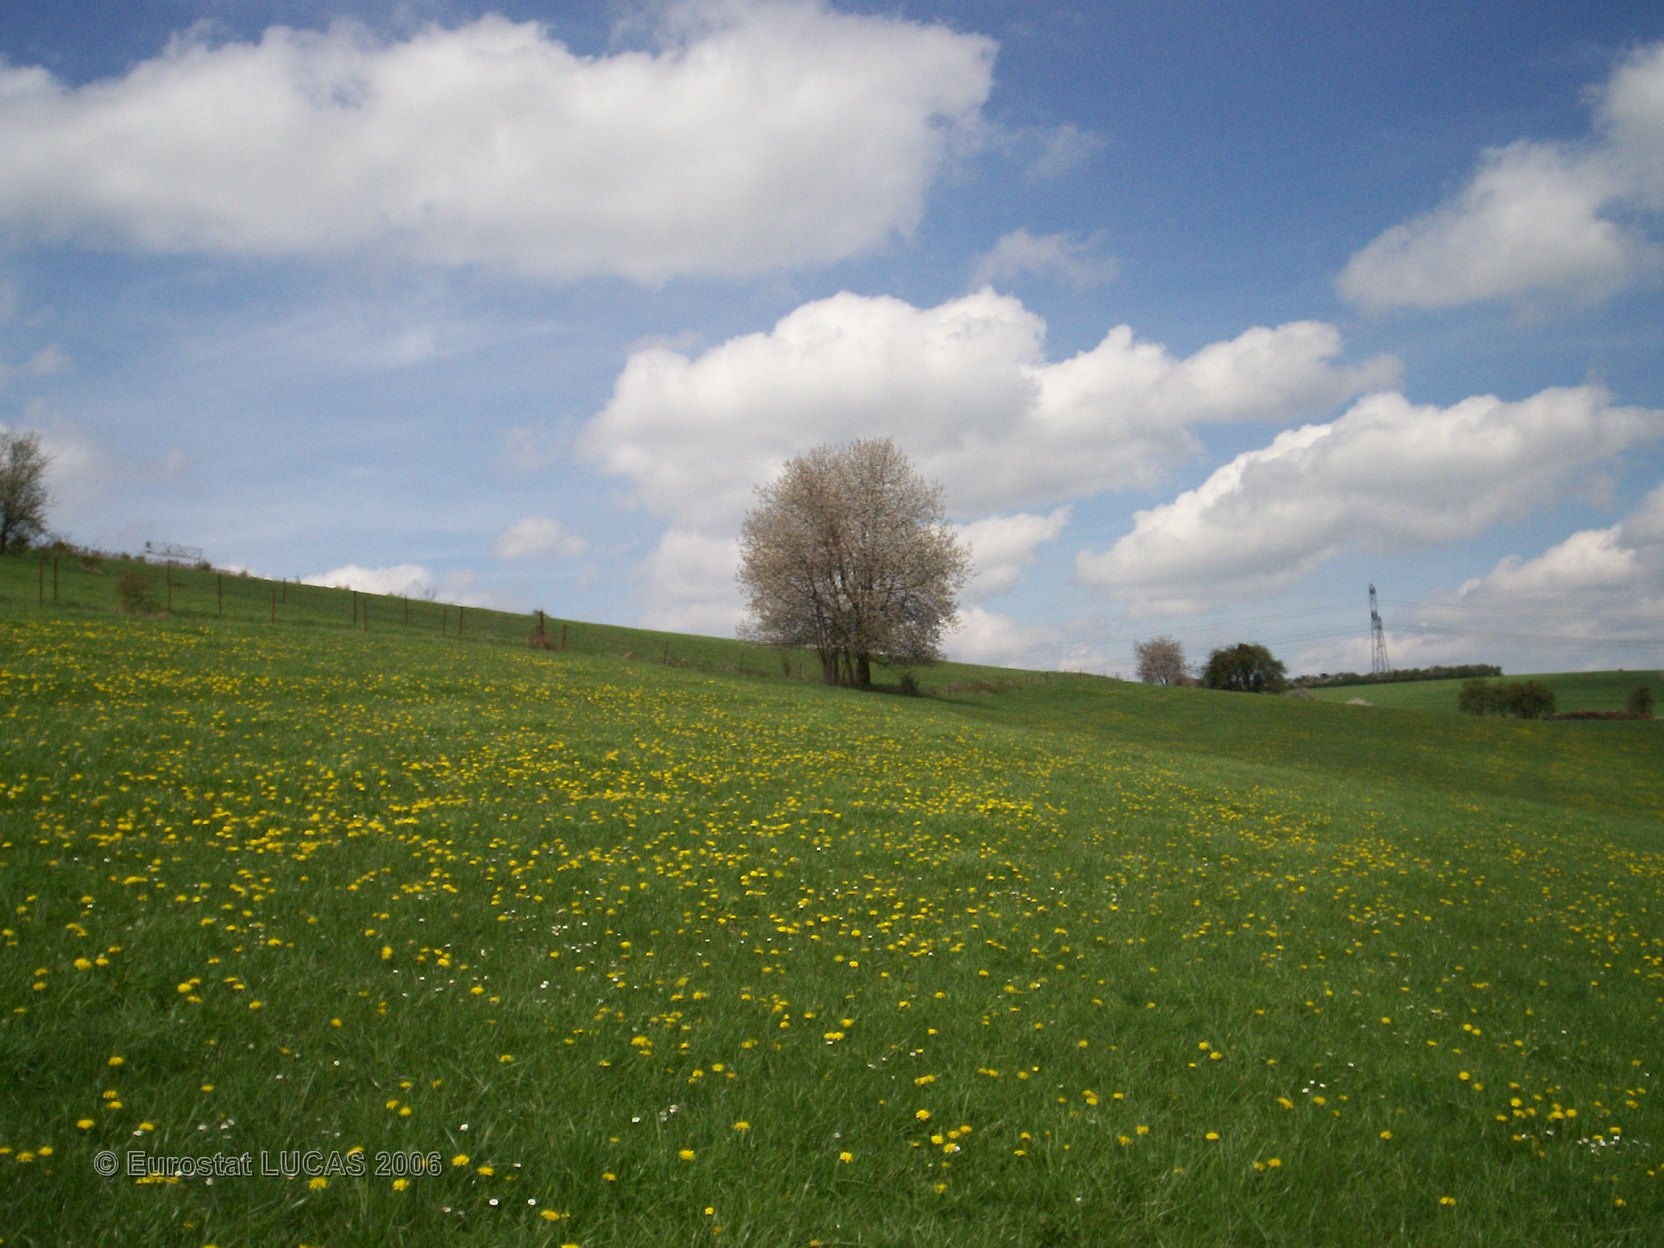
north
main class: Grassland
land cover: Grassland without tree/shrub cover
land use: Agriculture (excluding fallow land and kitchen gardens)
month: May
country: FR
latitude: 49.7942
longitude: 4.3974
